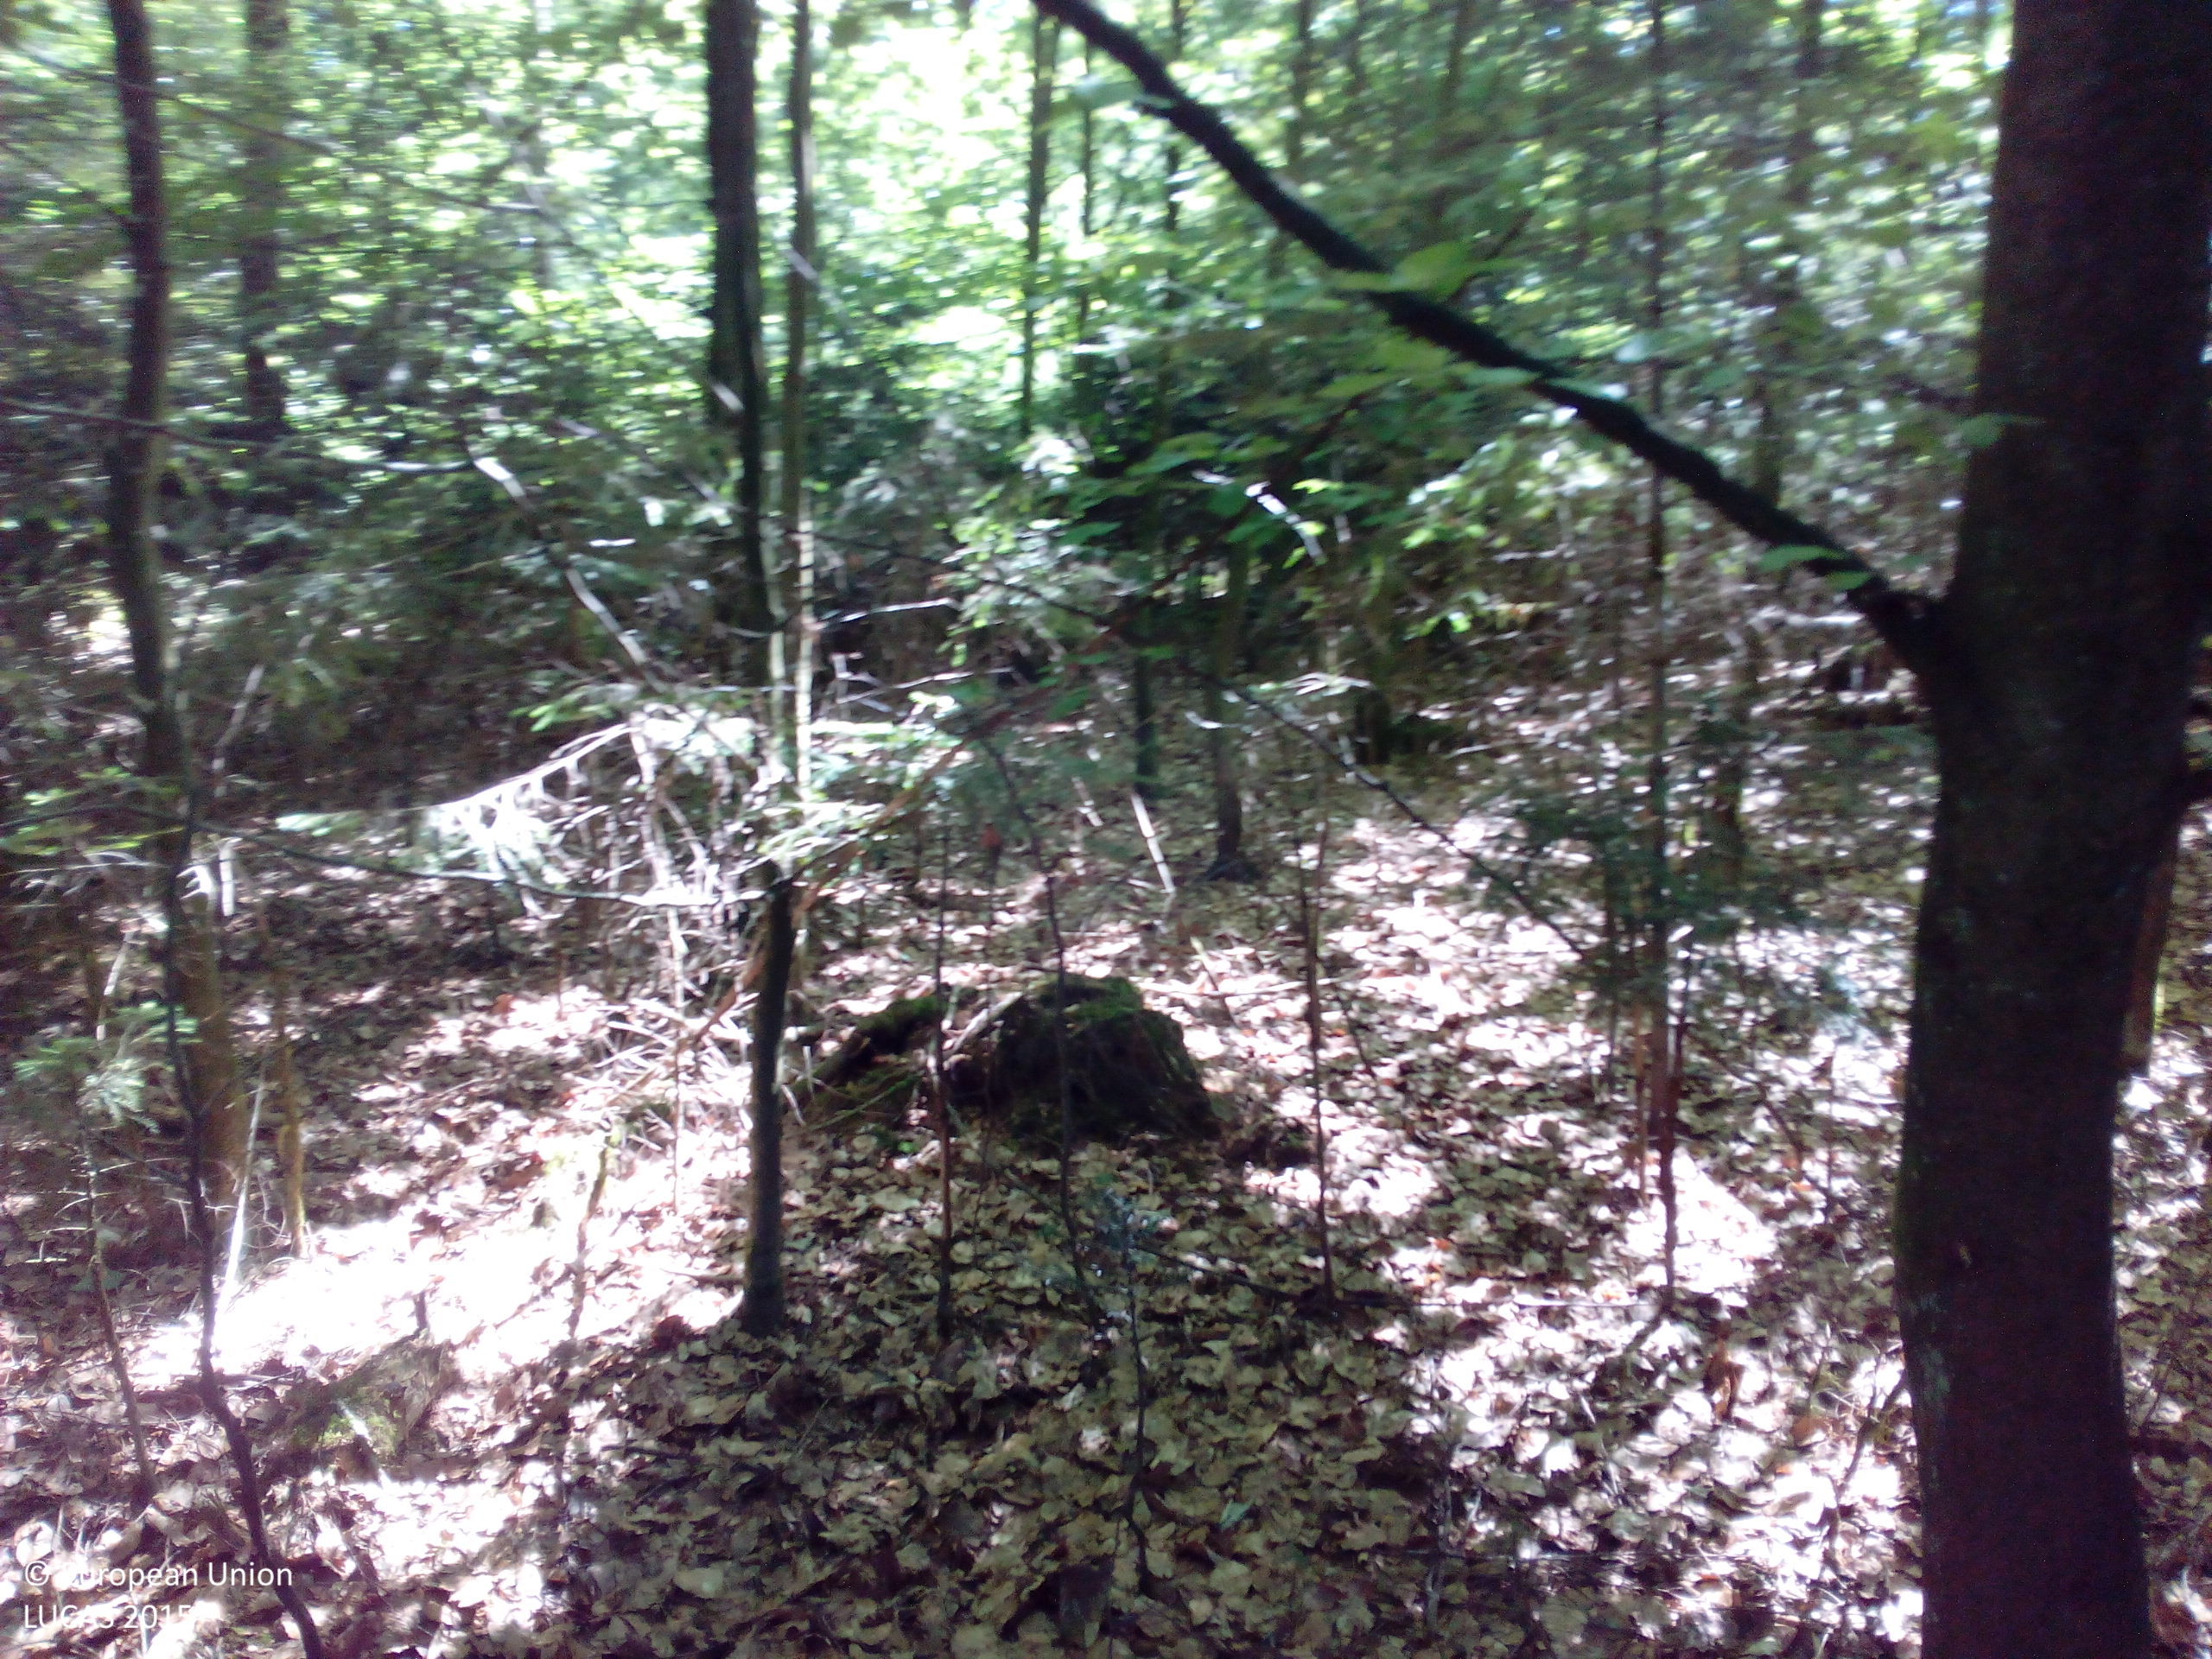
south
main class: Woodland
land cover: Spruce dominated mixed woodland
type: hemiboreal forest and nemoral coniferous forest and mixed broadleaved-coniferous forest
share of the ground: > 75 %
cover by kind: broadleaved forest trees 60 %, coniferous forest trees 30 %, unconsolidated bare surface 10 %
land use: Forestry
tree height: > 5 m
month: July
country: DE
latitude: 48.5877
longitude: 13.3210
